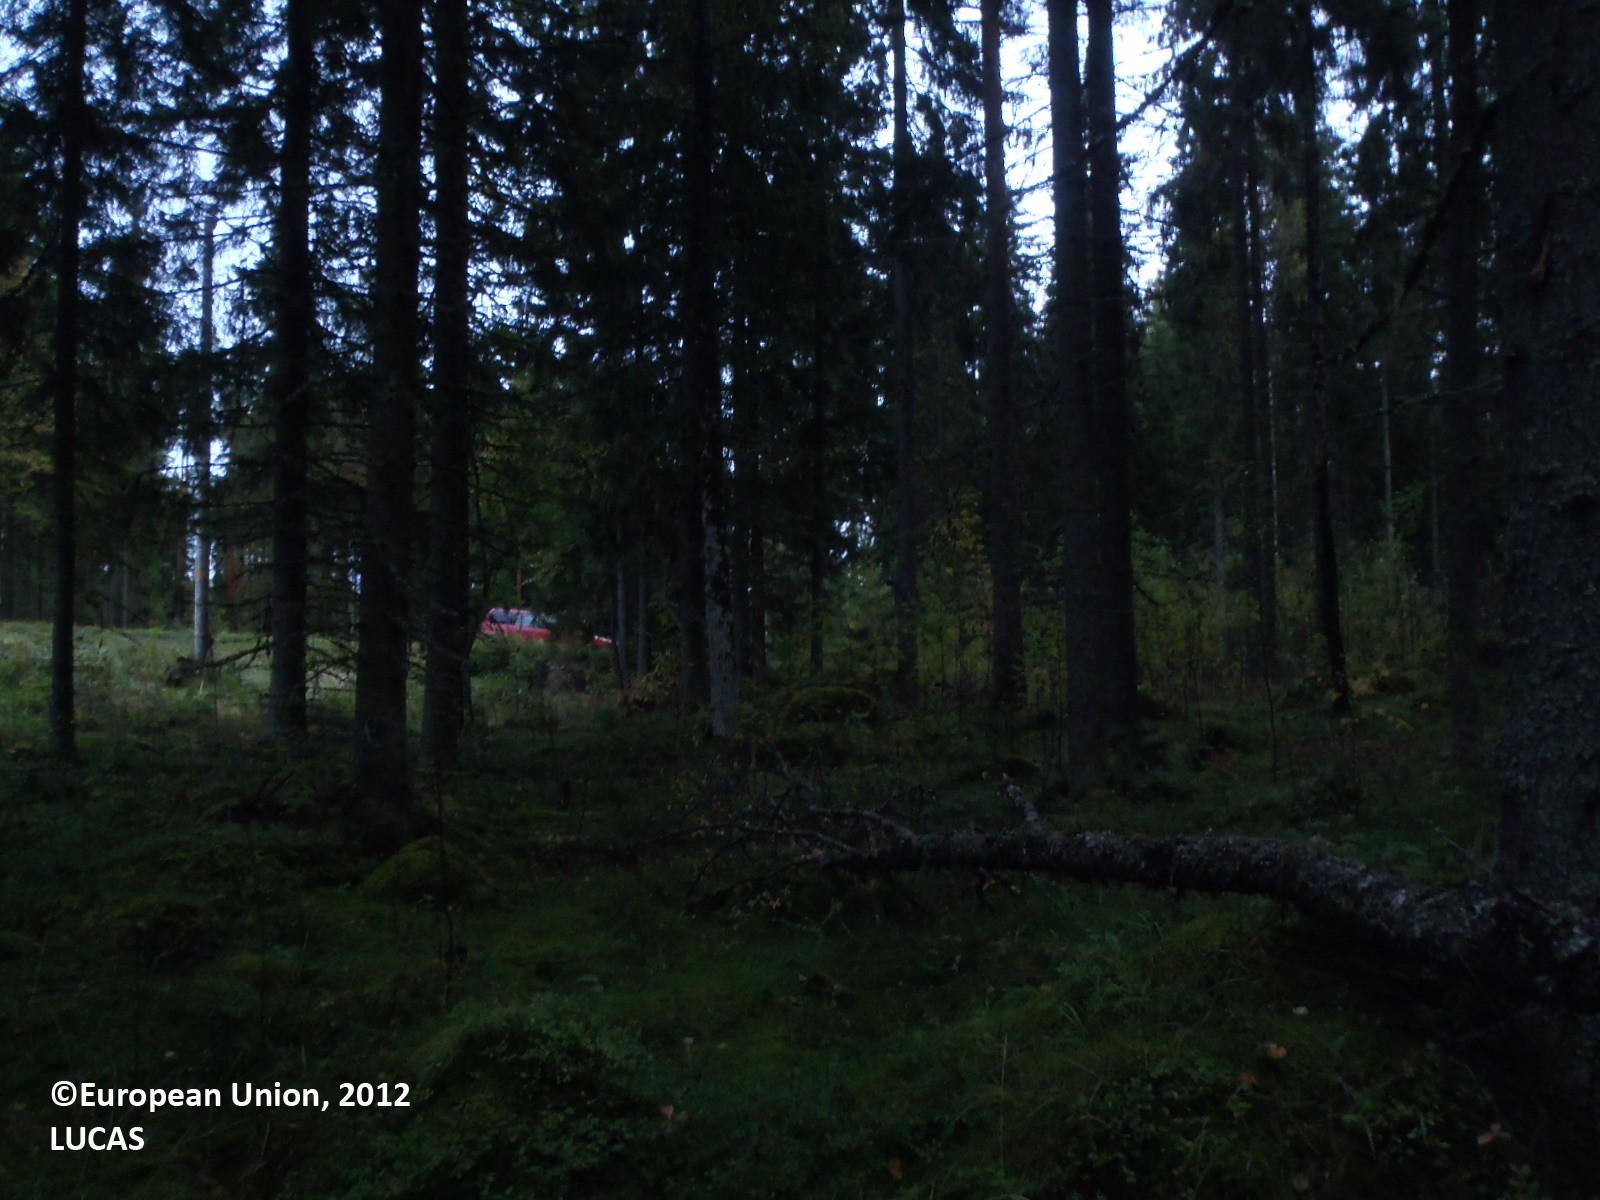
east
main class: Woodland
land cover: Spruce dominated coniferous woodland
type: boreal forest
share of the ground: > 75 %
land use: Forestry
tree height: > 5 m
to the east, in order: Spruce dominated coniferous woodland; Grass margins; Electric lines; Grass margins; Paved roads, cycling and walking lanes; Grass margins; Spruce dominated coniferous woodland; Spruce dominated mixed woodland; Spruce dominated coniferous woodland; Other bare soil
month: September
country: FI
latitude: 61.7110
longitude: 22.6424
